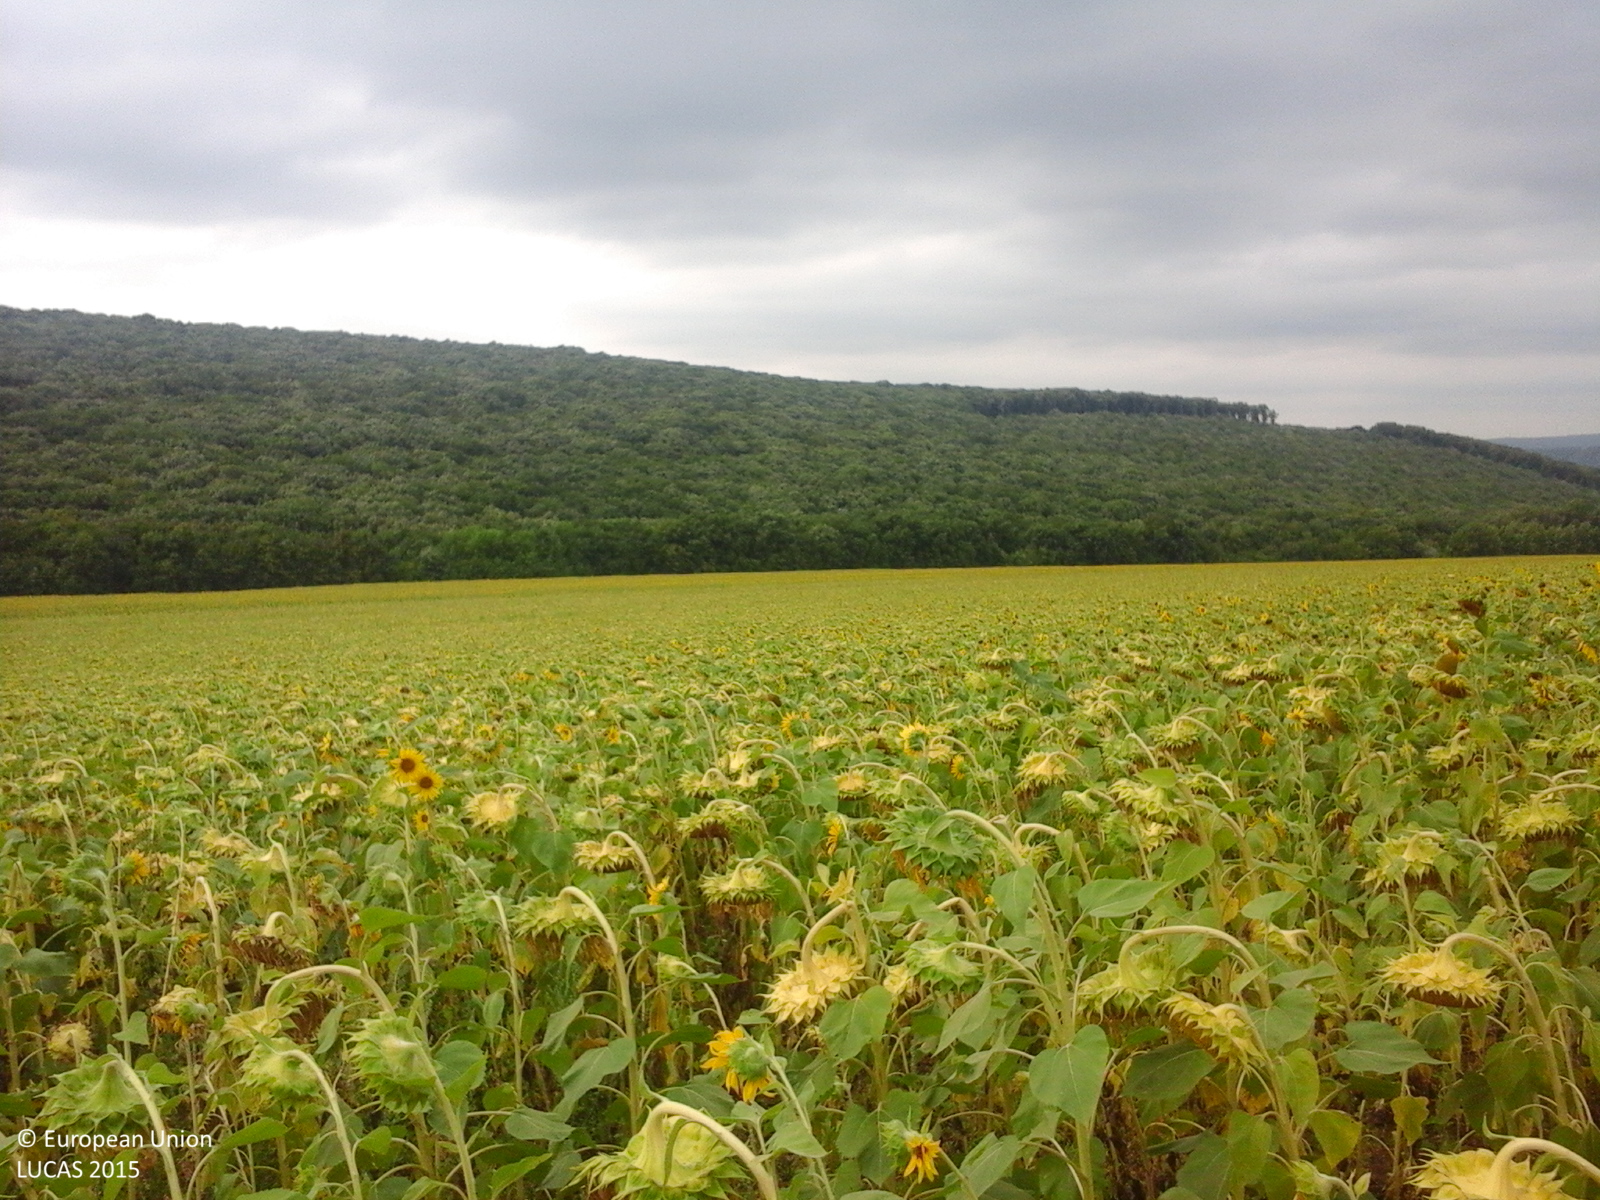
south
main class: Cropland
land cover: Sunflower
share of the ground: > 75 %
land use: Agriculture (excluding fallow land and kitchen gardens)
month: August
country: RO
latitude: 44.8587
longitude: 28.6462
